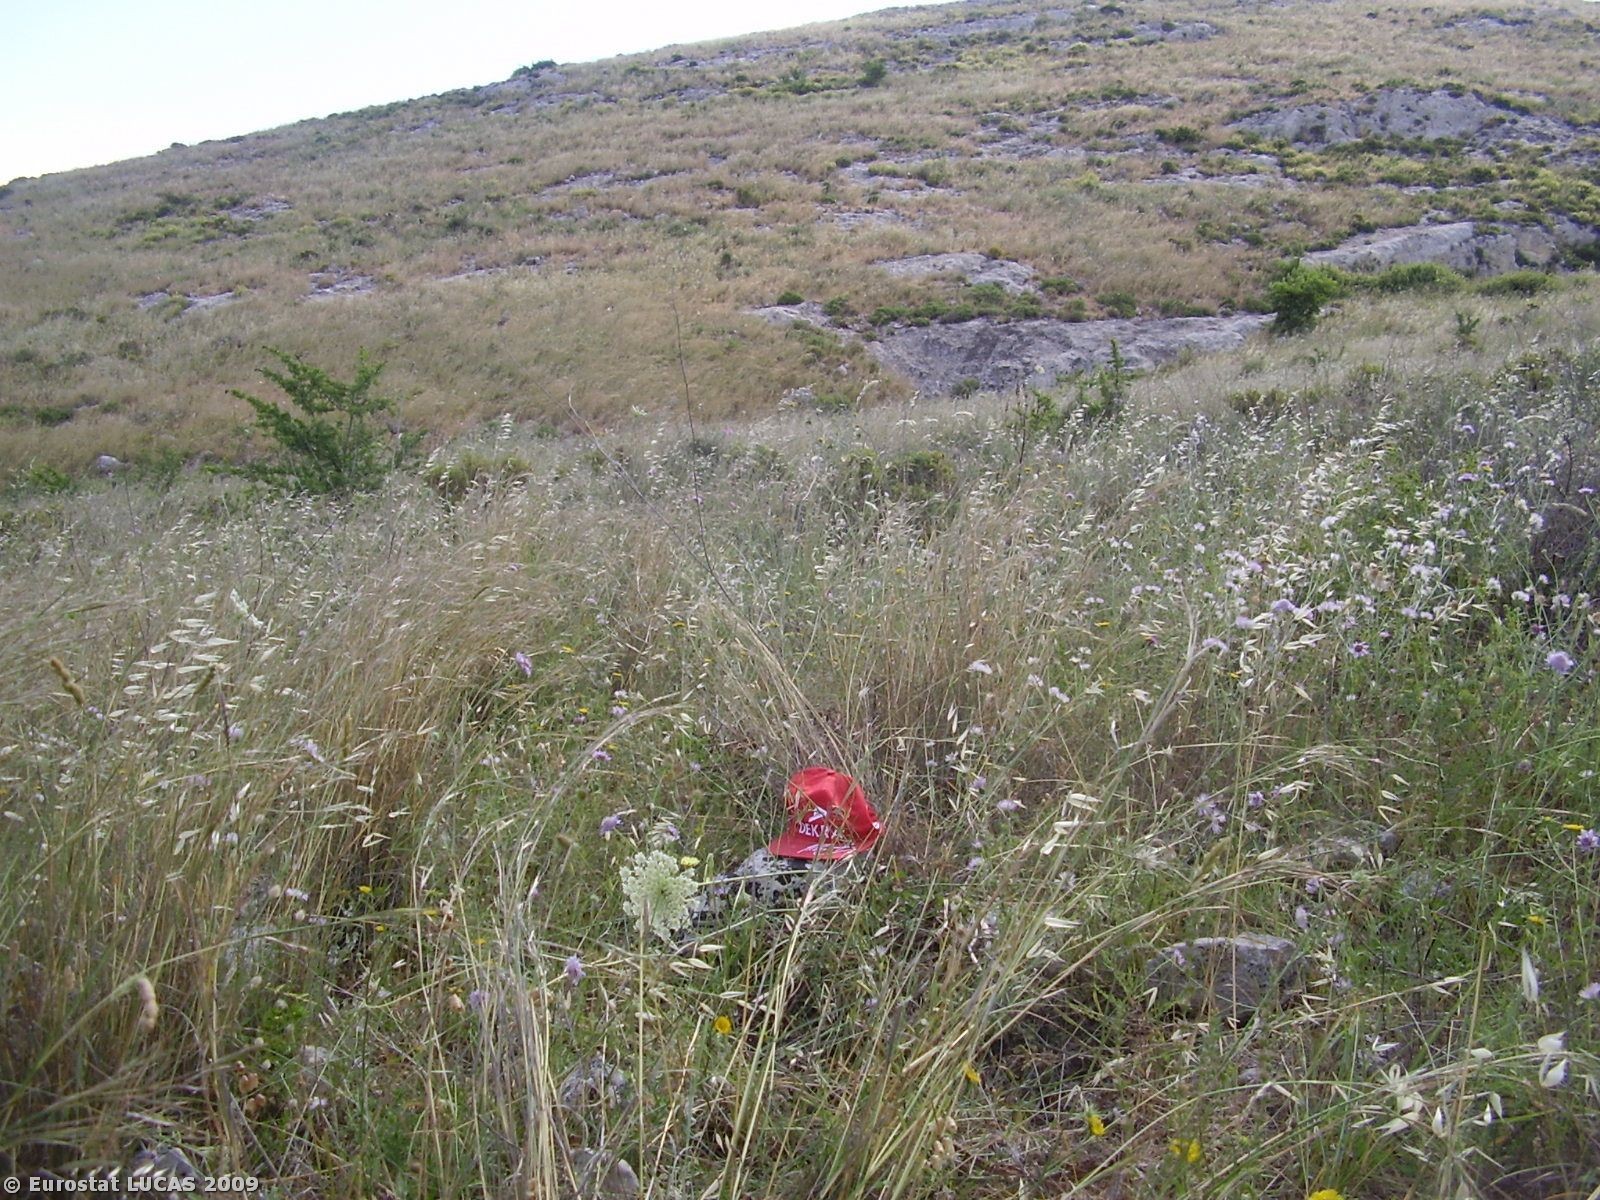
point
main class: Grassland
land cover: Grassland without tree/shrub cover
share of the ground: > 75 %
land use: Agriculture (excluding fallow land and kitchen gardens)
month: June
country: IT
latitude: 37.2001
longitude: 14.9537
